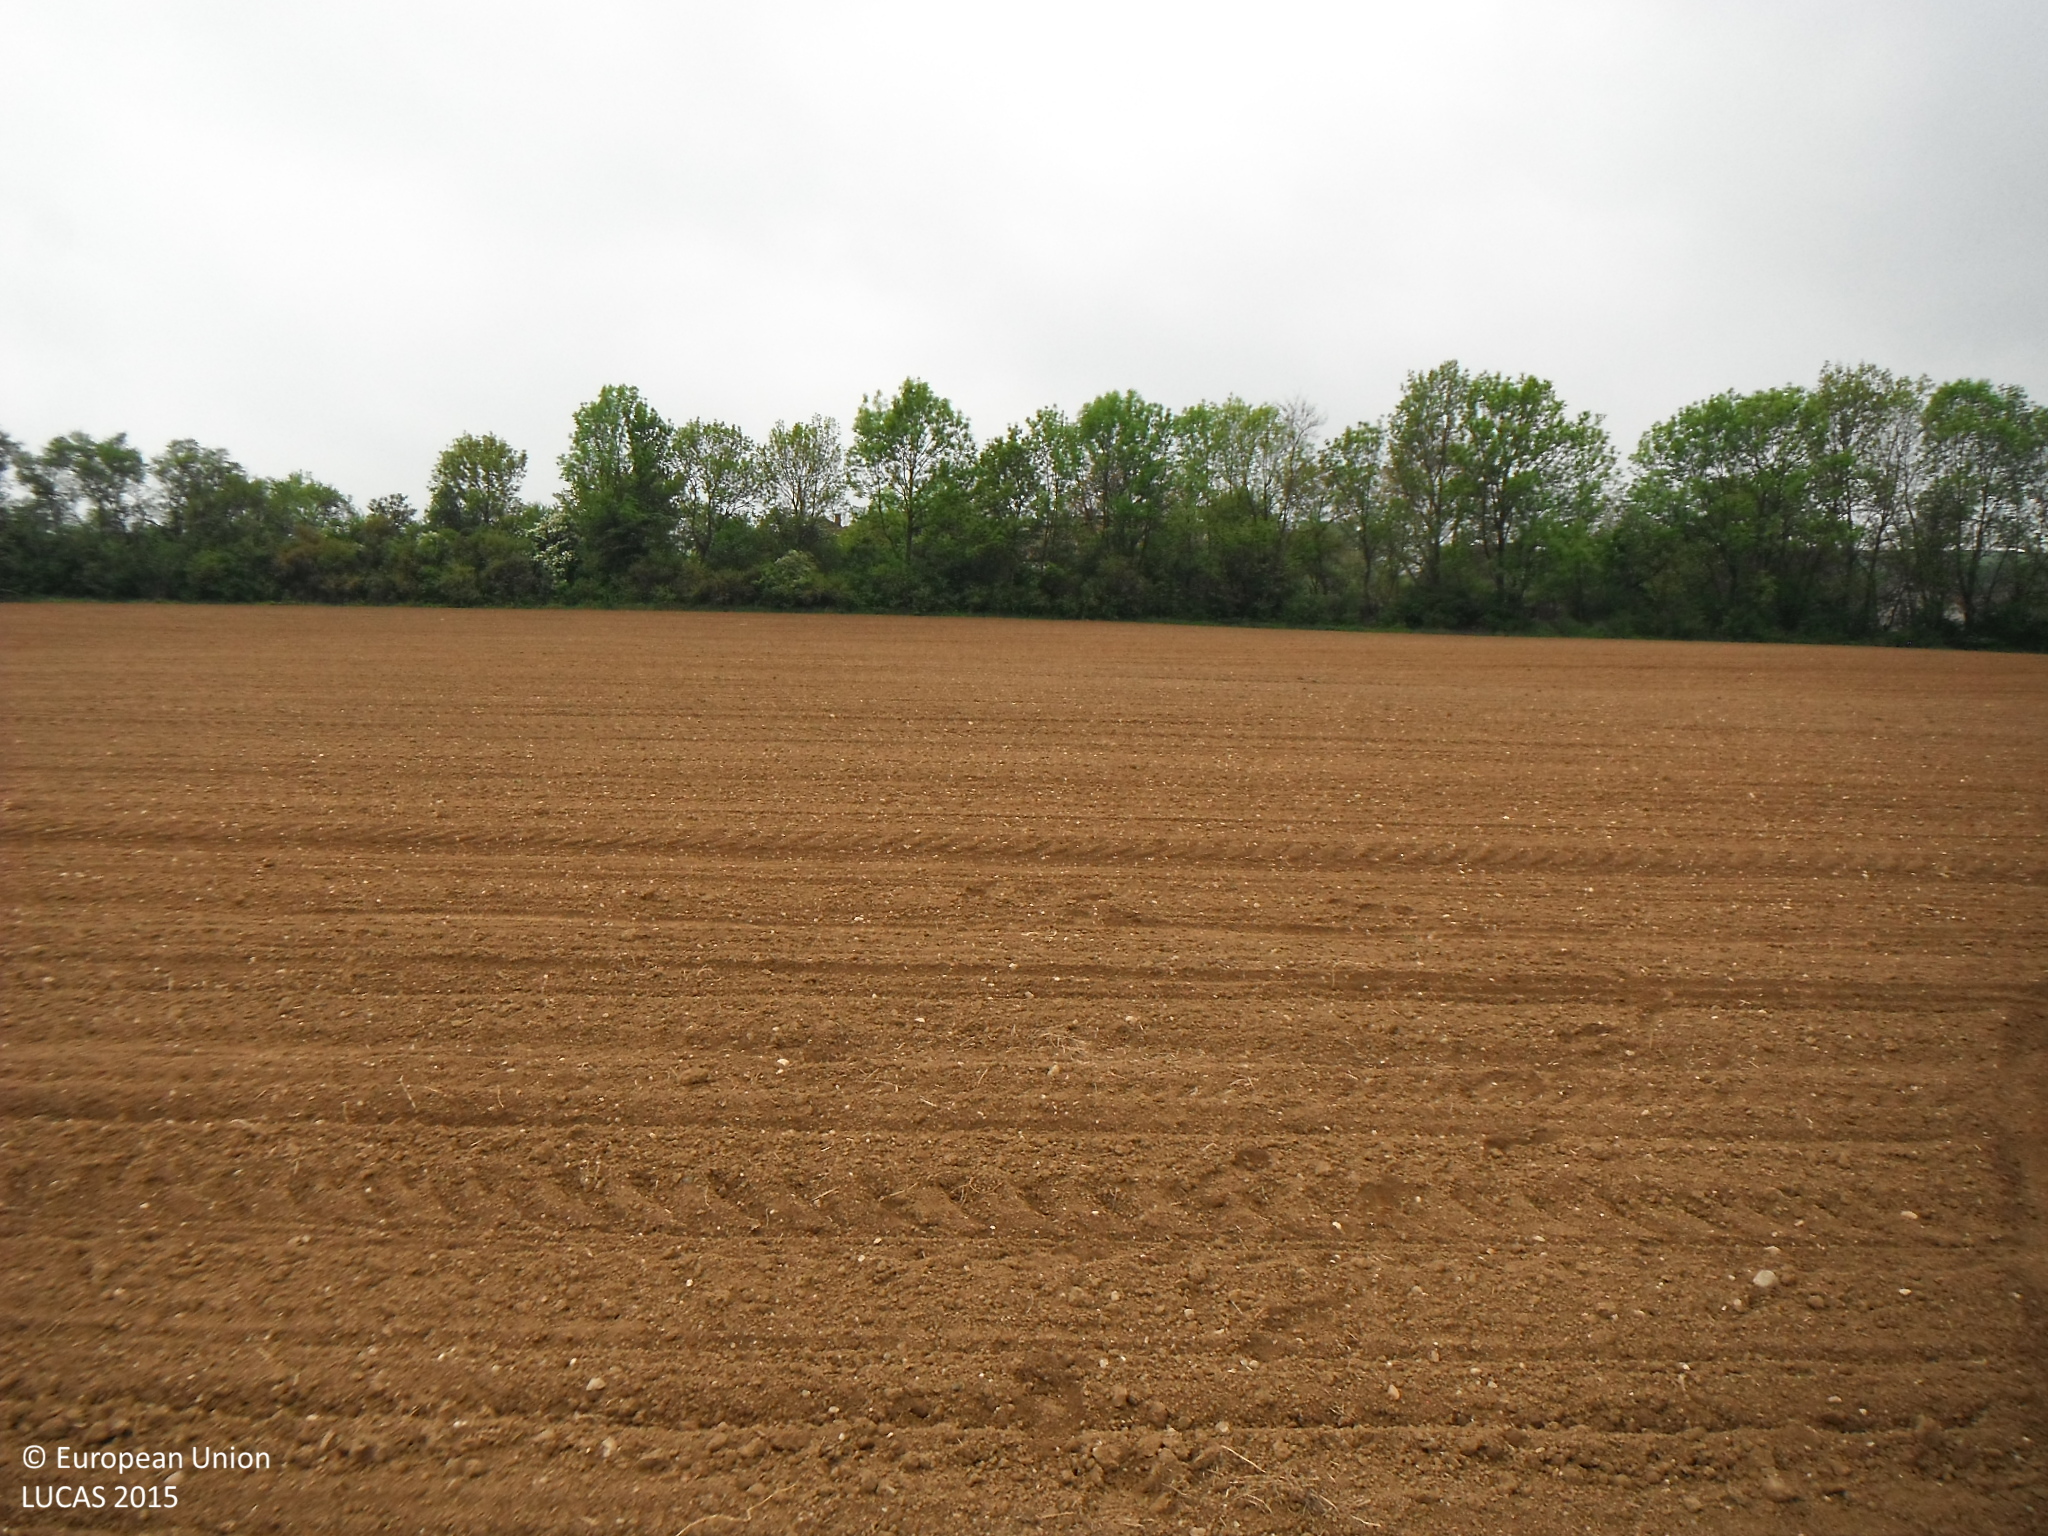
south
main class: Cropland
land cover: Maize
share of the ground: < 10 %
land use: Agriculture (excluding fallow land and kitchen gardens)
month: May
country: SK
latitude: 48.5295
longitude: 21.1329
